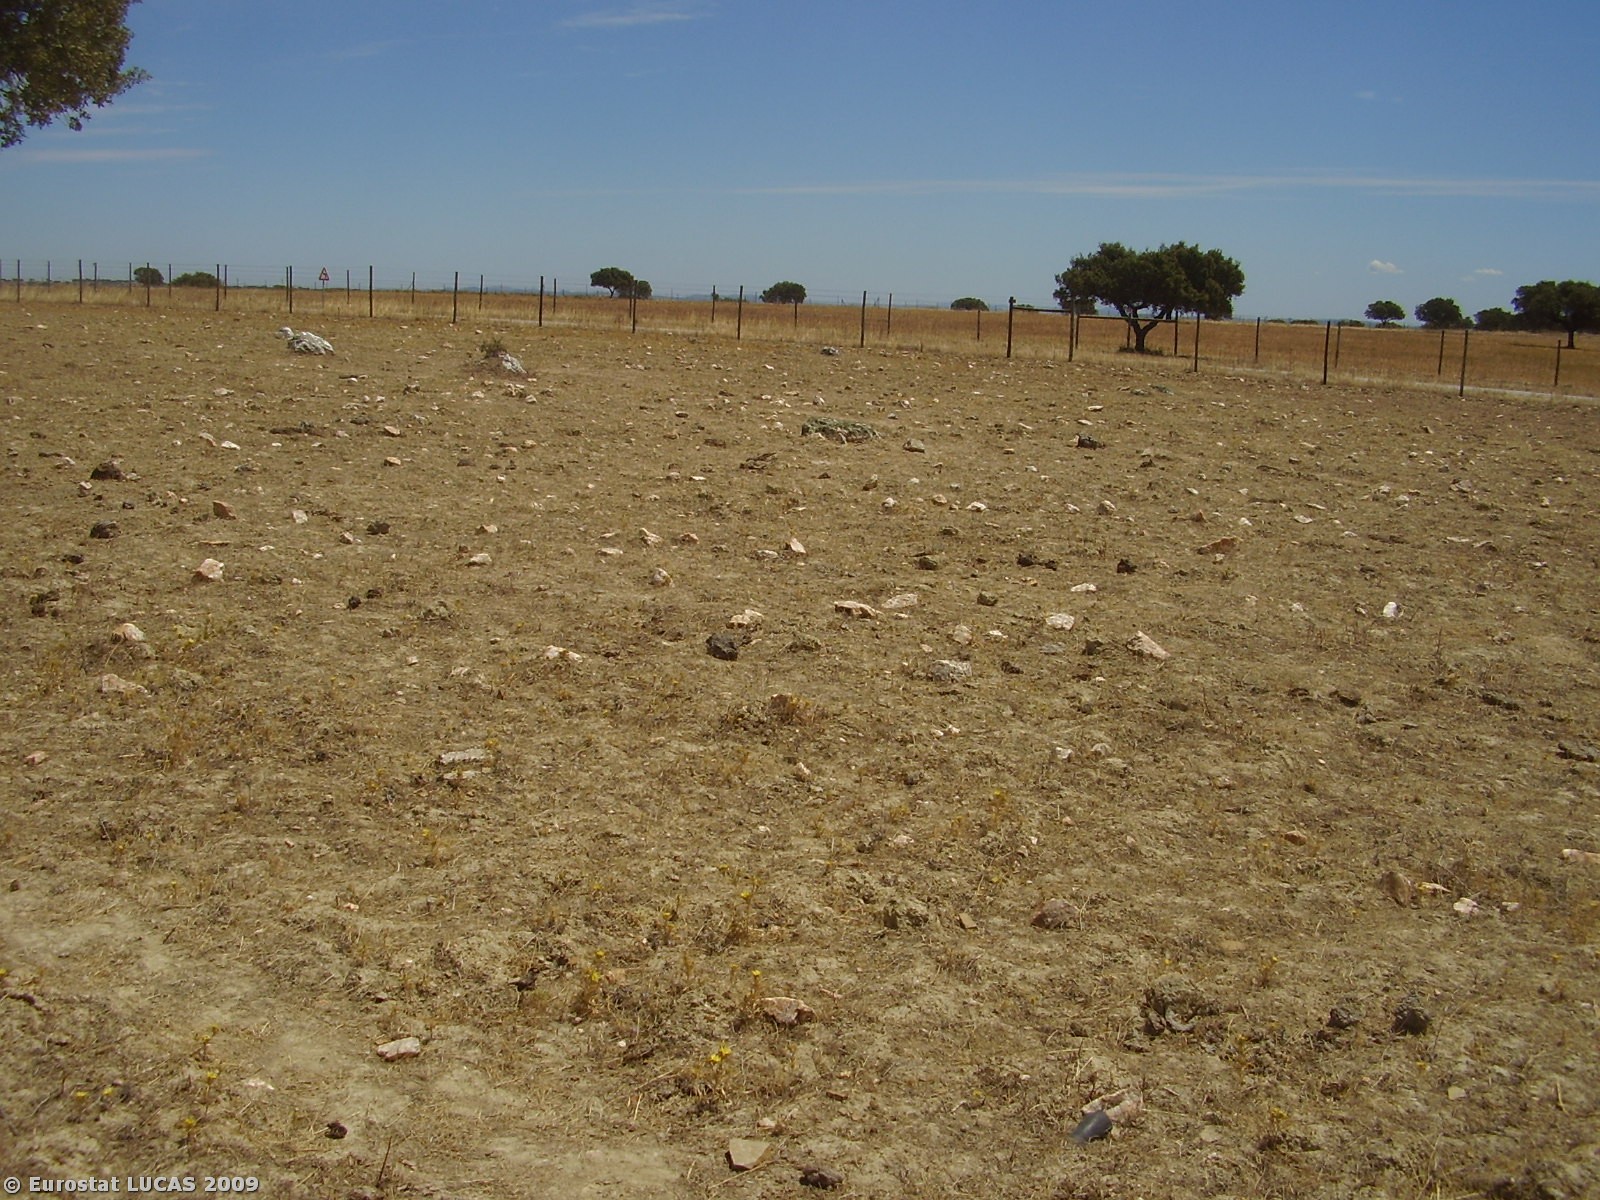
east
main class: Grassland
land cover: Grassland with sparse tree/shrub cover
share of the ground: > 75 %
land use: Fallow land
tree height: > 5 m
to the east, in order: Grassland with sparse tree/shrub cover; Fences; Grass margins; Ditches and canals; Paved roads, cycling and walking lanes; Ditches and canals; Grass margins; Paved roads, cycling and walking lanes; Ditches and canals; Grass margins; Fences; Grassland without tree/shrub cover; Fences; Tracks; Grass margins; Fences; Grassland with sparse tree/shrub cover
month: August
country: PT
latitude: 38.2255
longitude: -7.1621
